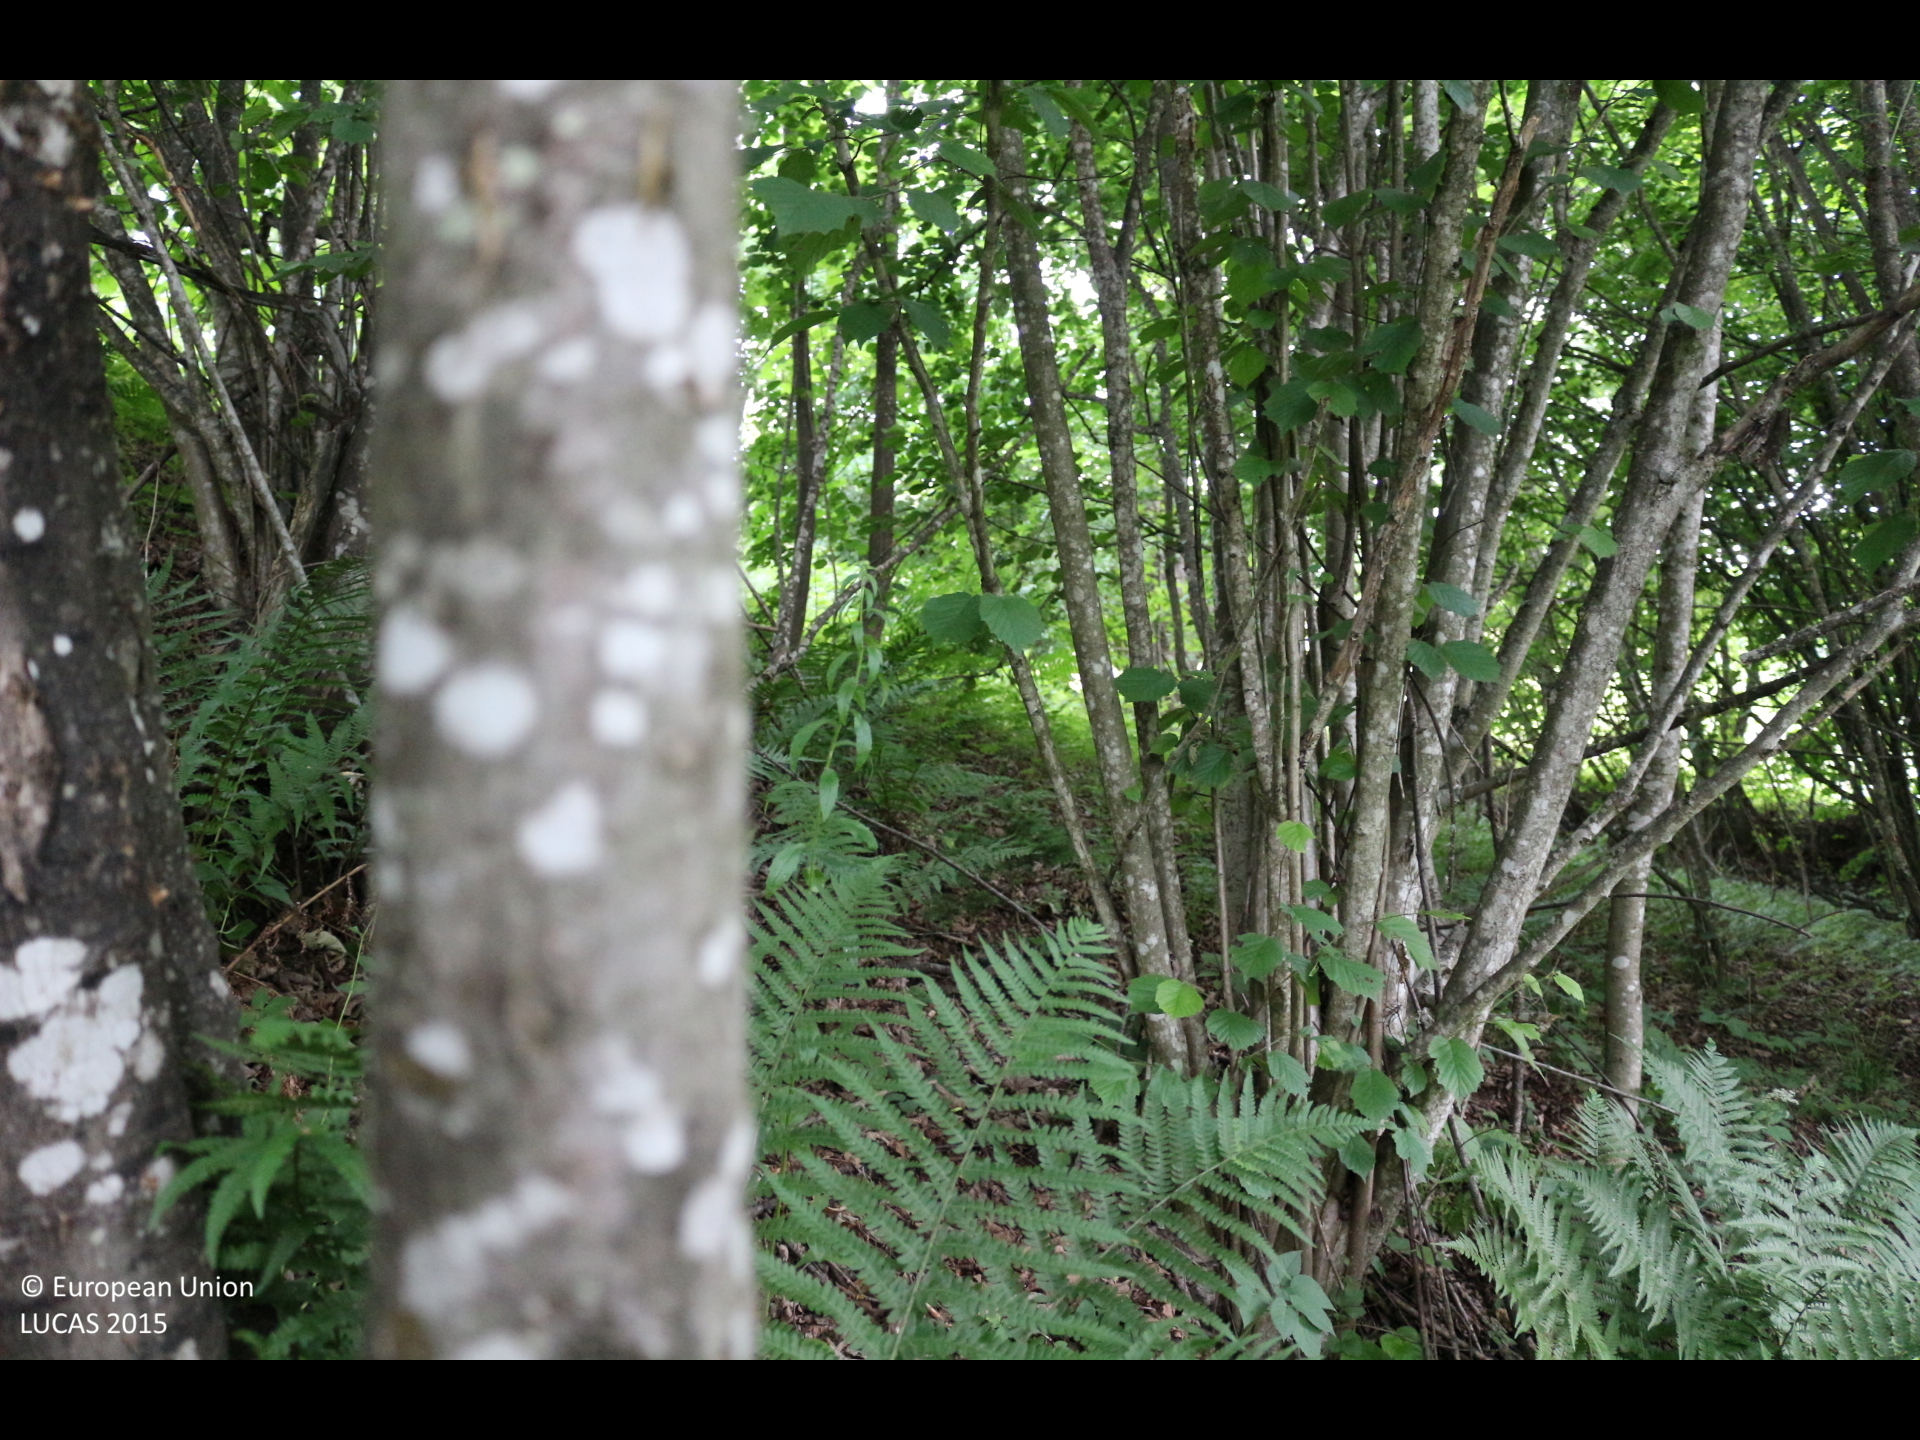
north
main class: Woodland
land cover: Broadleaved woodland
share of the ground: > 75 %
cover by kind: broadleaved forest trees 90 %, herbaceous plants 10 %
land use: Forestry
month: June
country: AT
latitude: 46.8784
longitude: 14.2886
